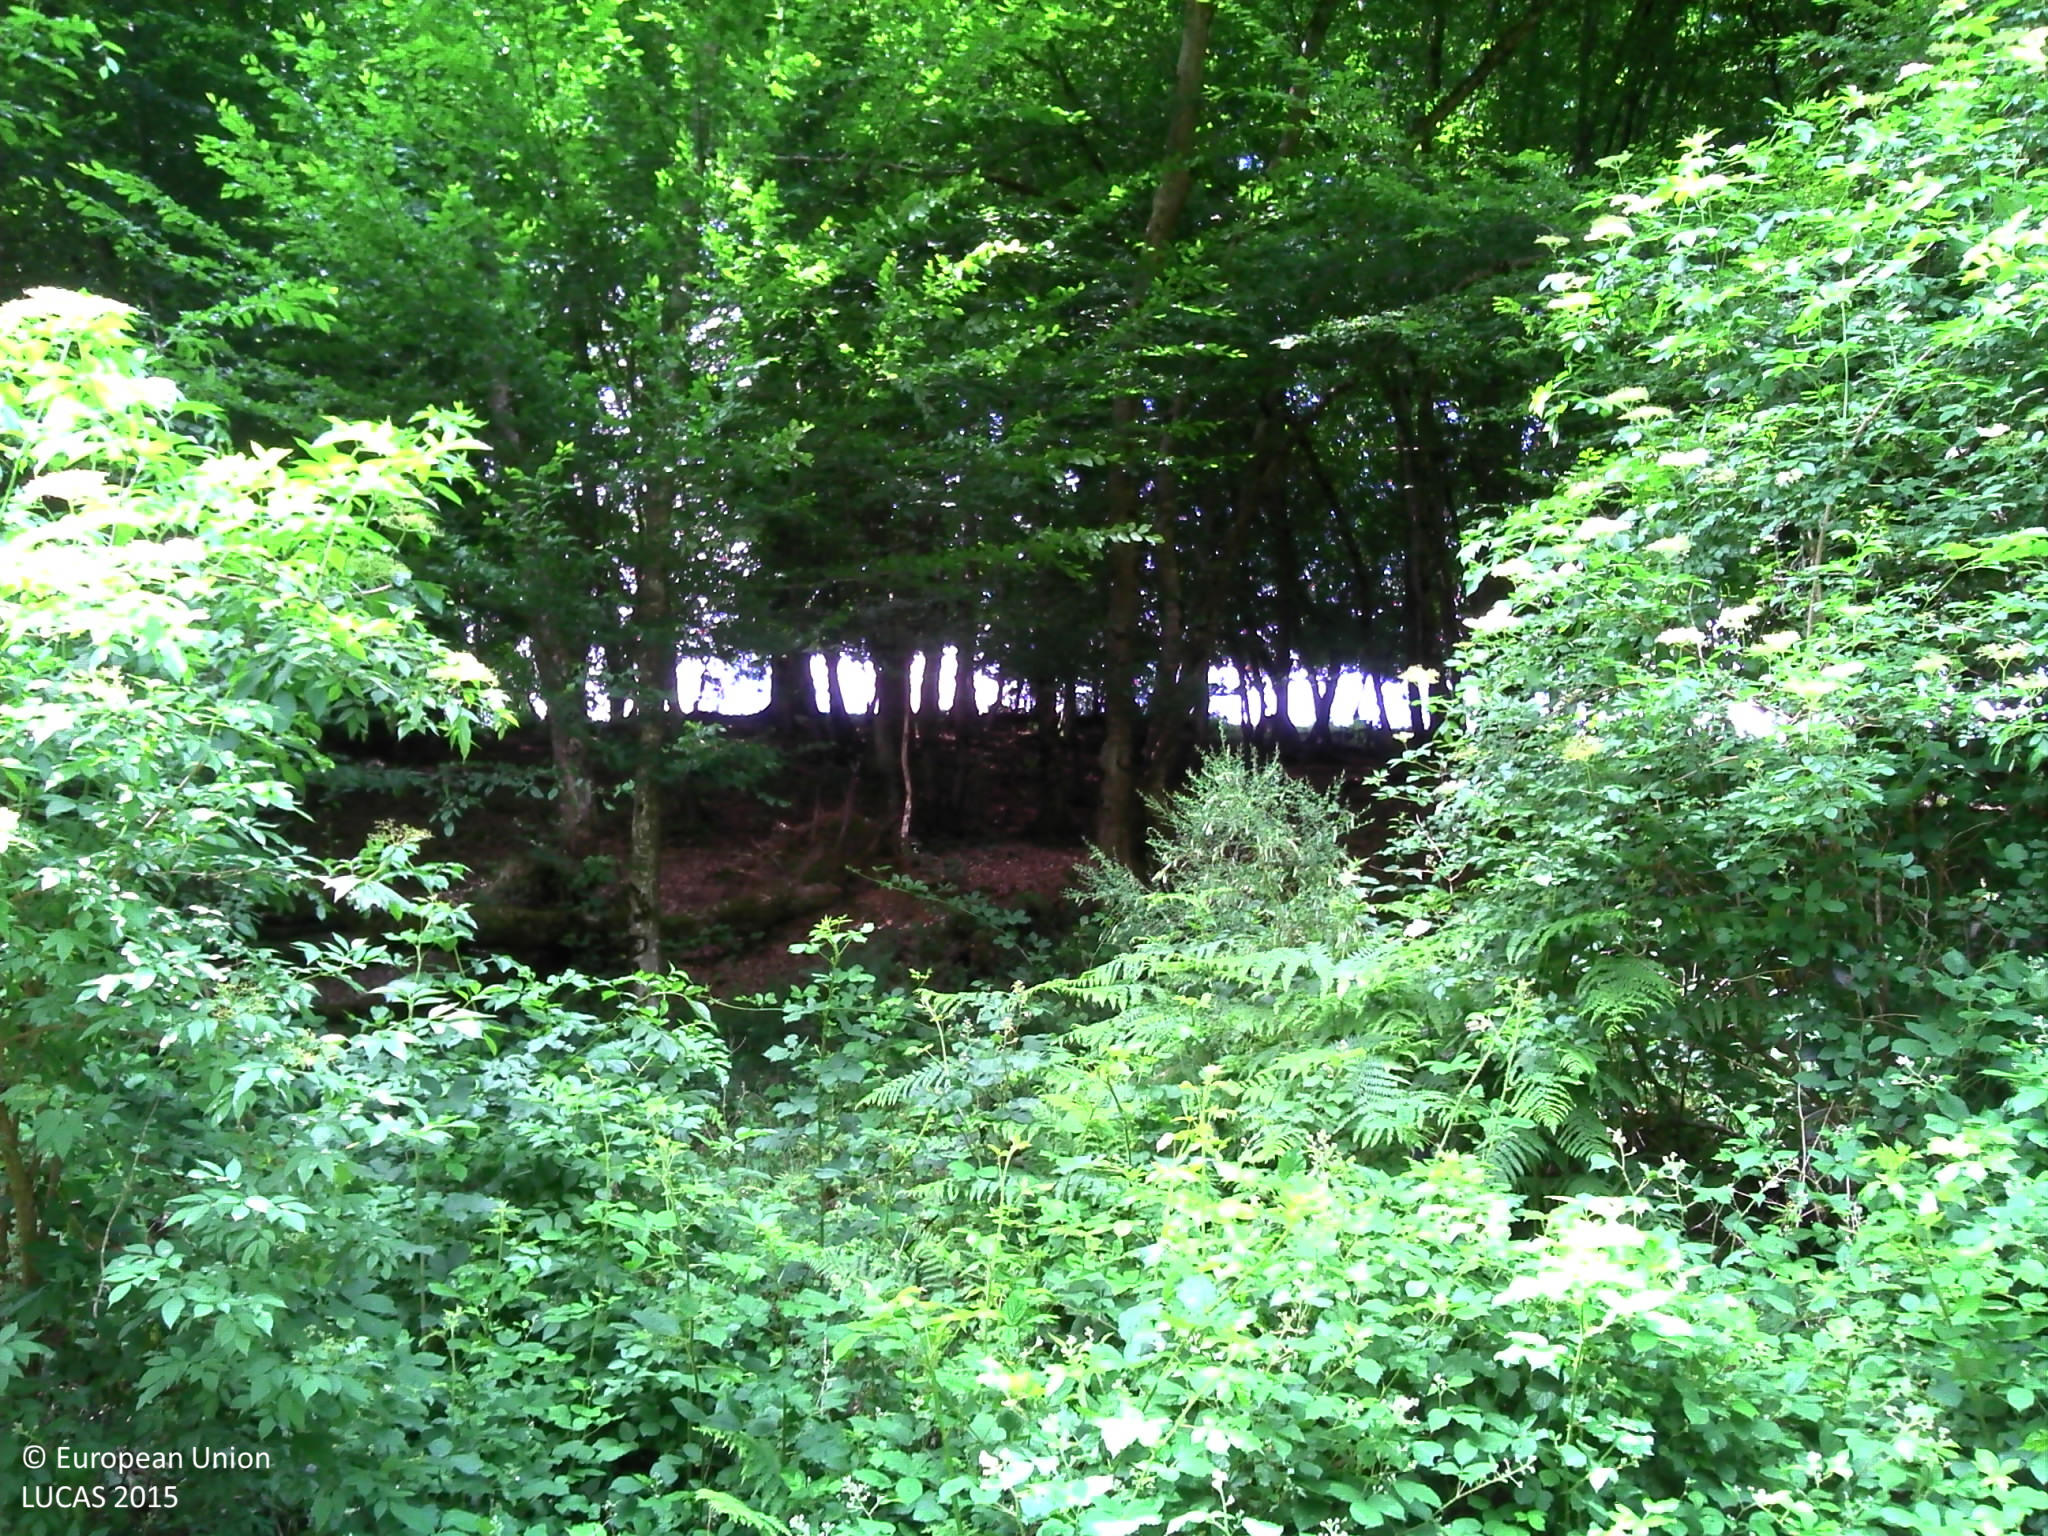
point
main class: Woodland
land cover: Broadleaved woodland
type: mesophytic deciduous forest
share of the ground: > 75 %
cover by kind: broadleaved forest trees 90 %, shrubs 10 %
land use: Forestry
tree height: > 5 m
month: June
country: FR
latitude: 46.2846
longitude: 3.0021
